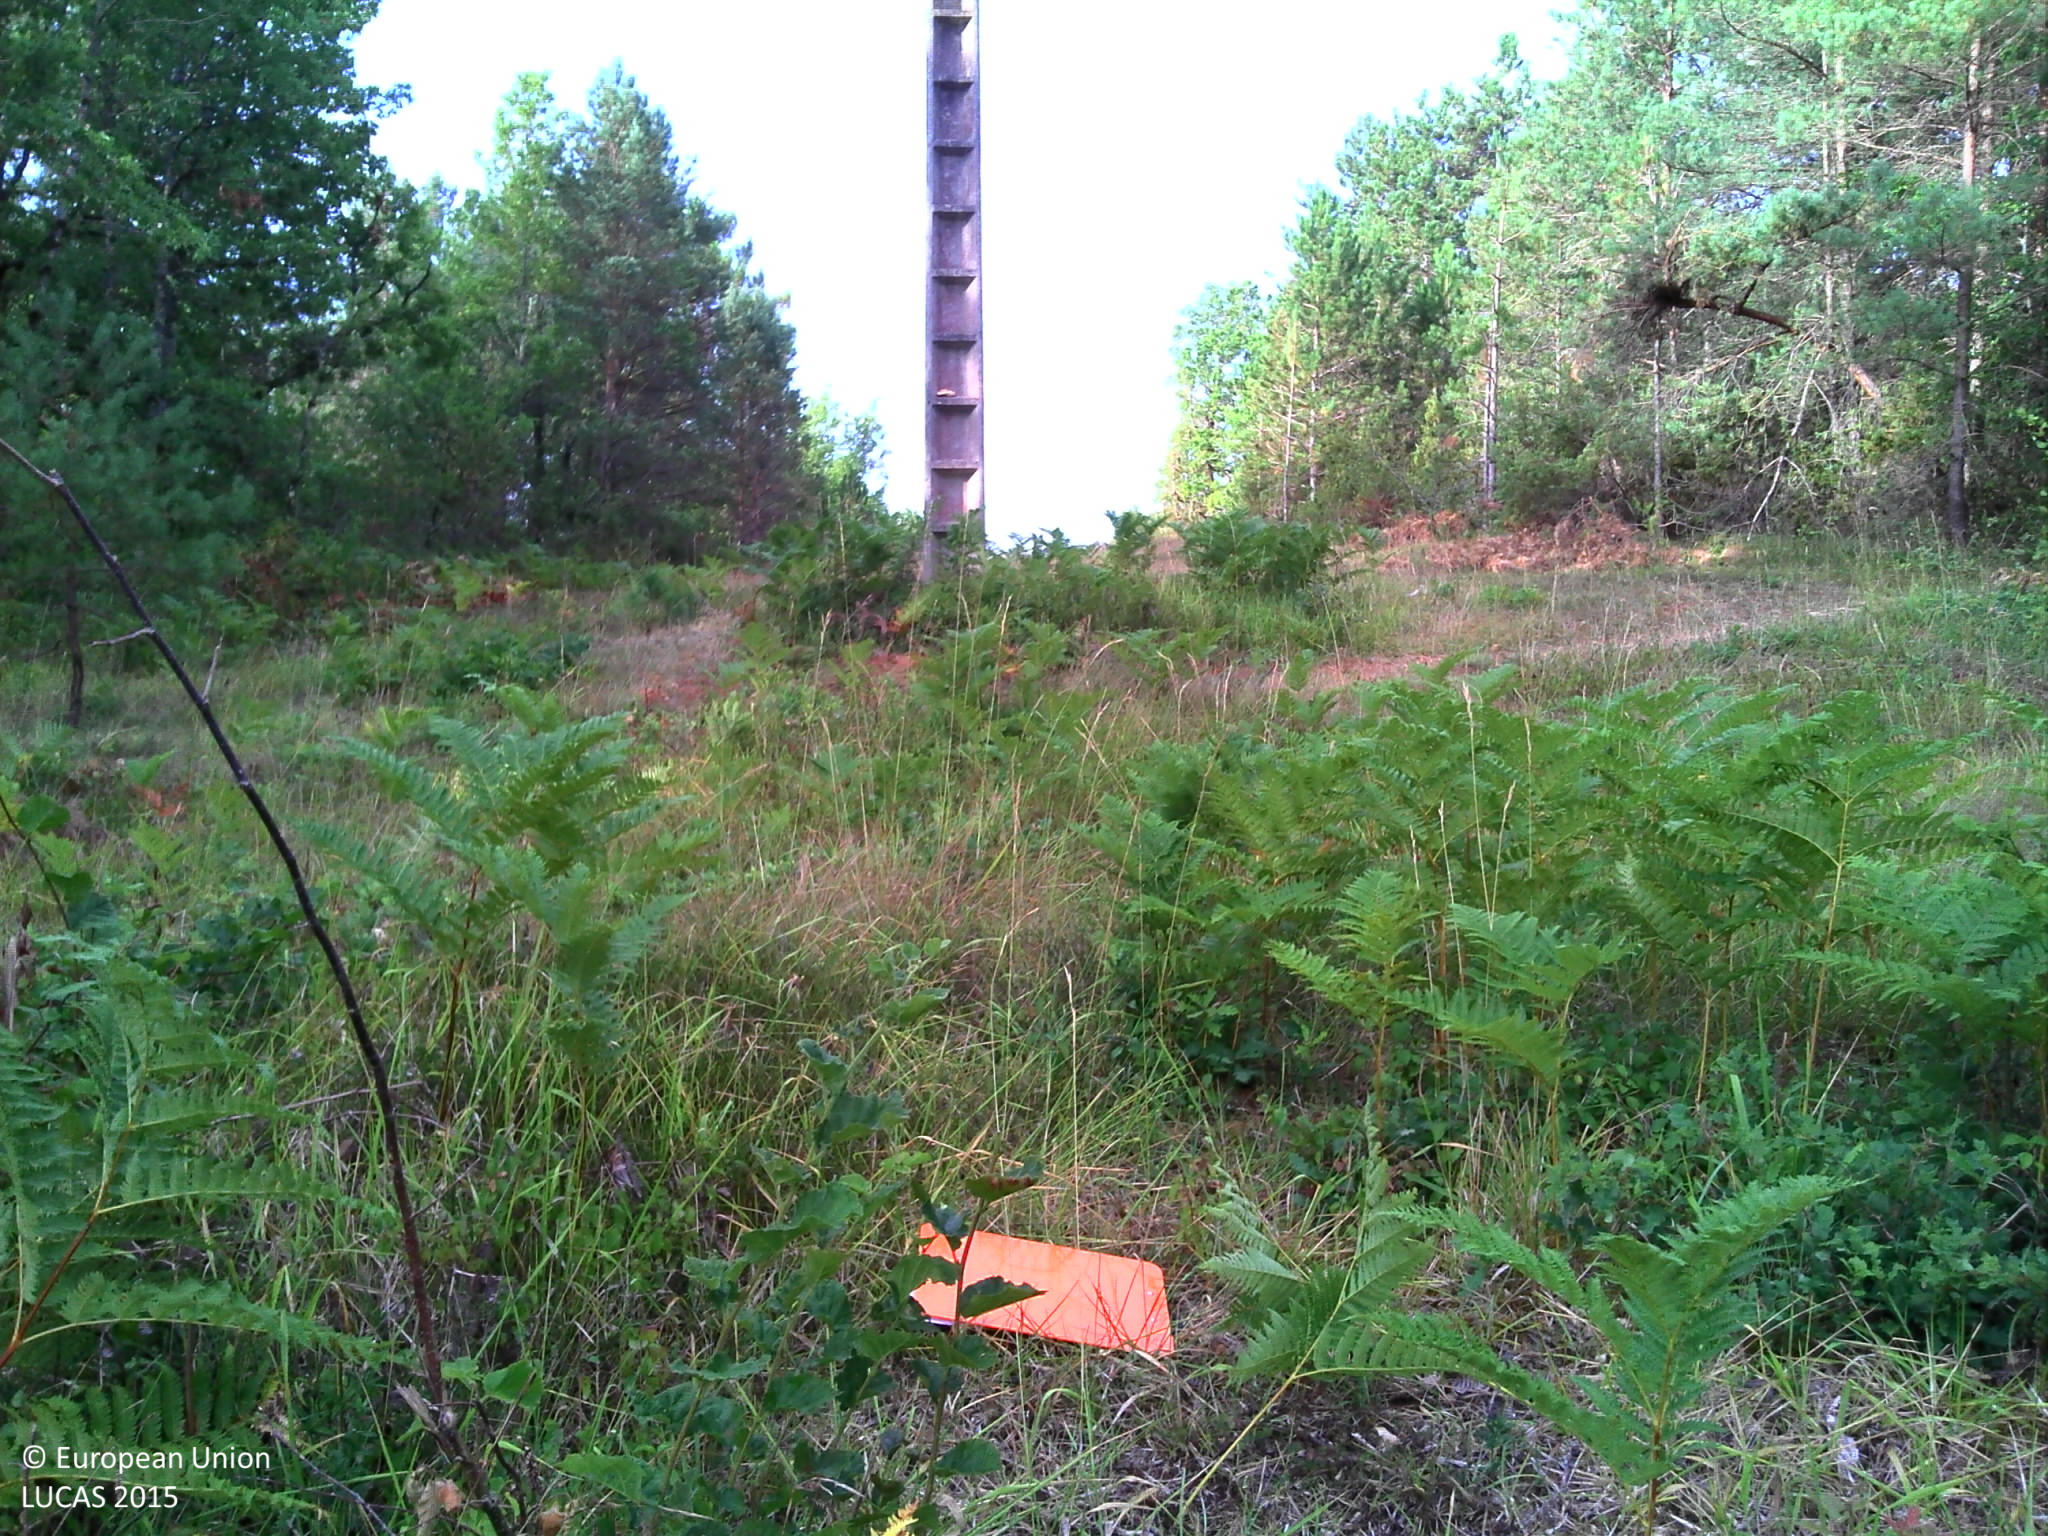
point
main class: Grassland
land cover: Spontaneously vegetated surfaces
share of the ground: > 75 %
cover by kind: herbaceous plants 90 %, shrubs 5 %, lichens and mosses 5 %
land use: Semi-natural and natural areas not in use
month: July
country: FR
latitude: 44.9213
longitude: 0.8074
